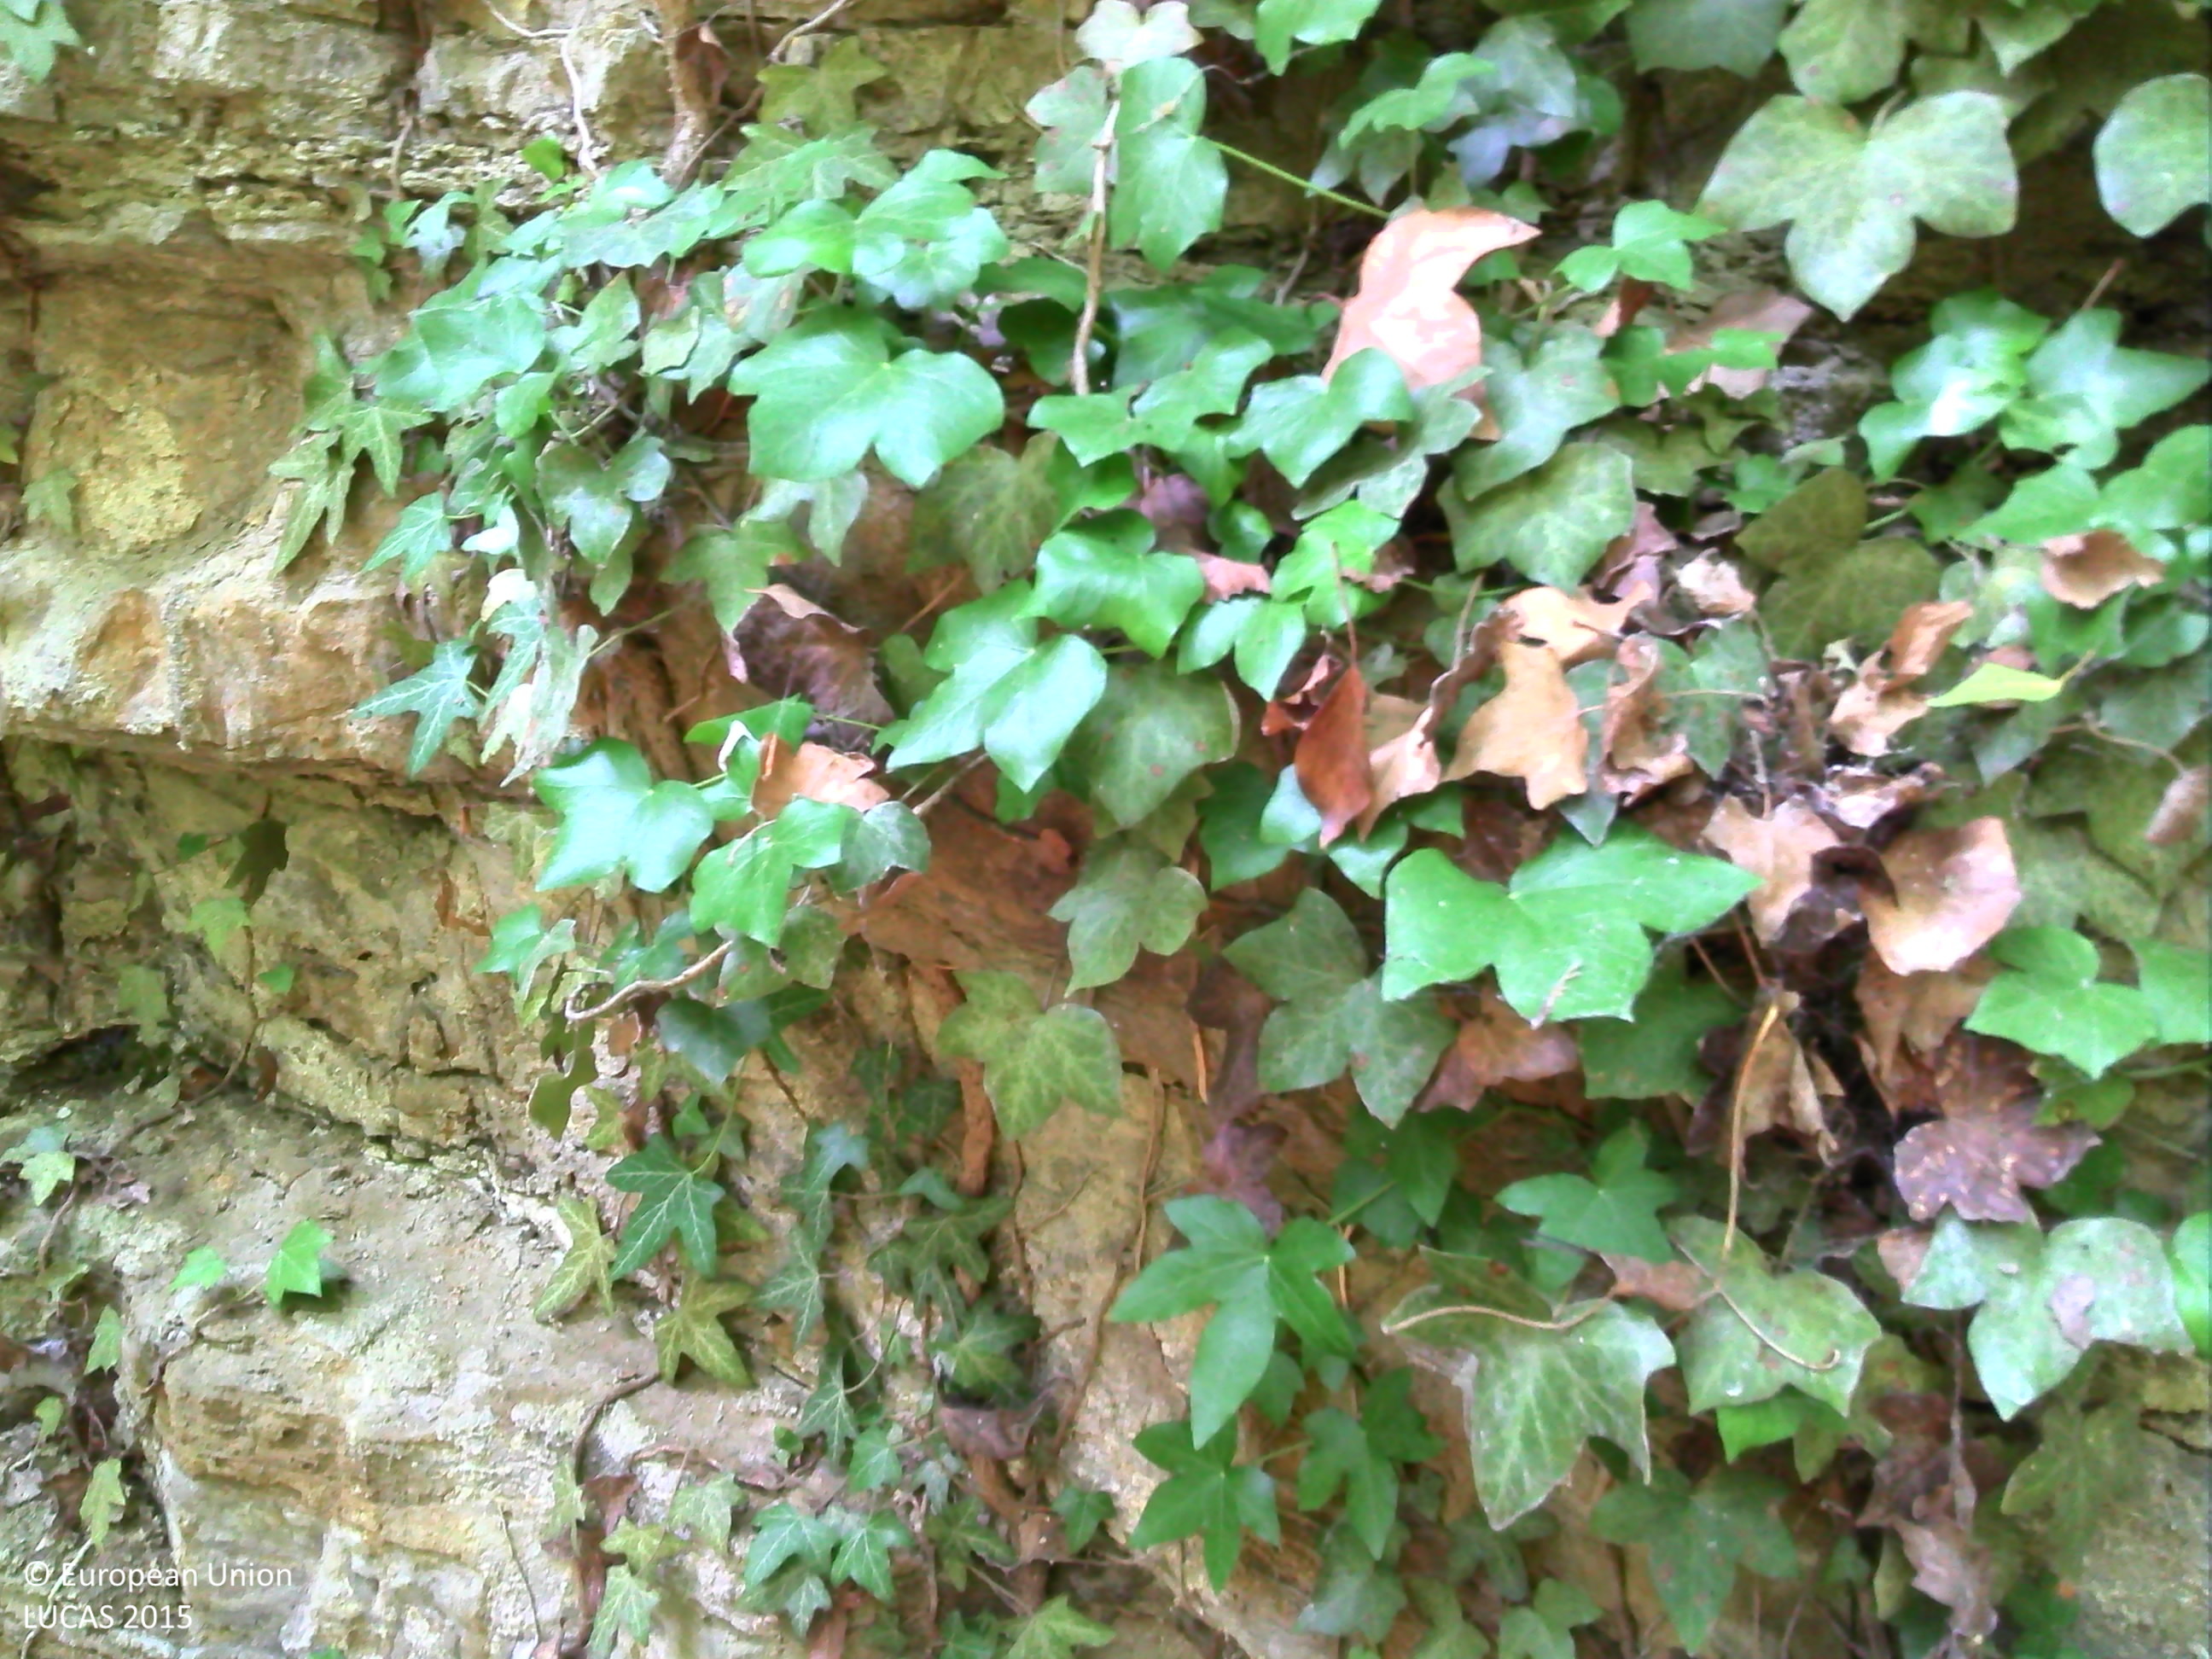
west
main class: Woodland
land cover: Broadleaved woodland
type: mesophytic deciduous forest
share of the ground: > 75 %
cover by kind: broadleaved forest trees 90 %, herbaceous plants 10 %
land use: Forestry
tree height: > 5 m
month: July
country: BE
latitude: 50.5711
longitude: 5.6921
